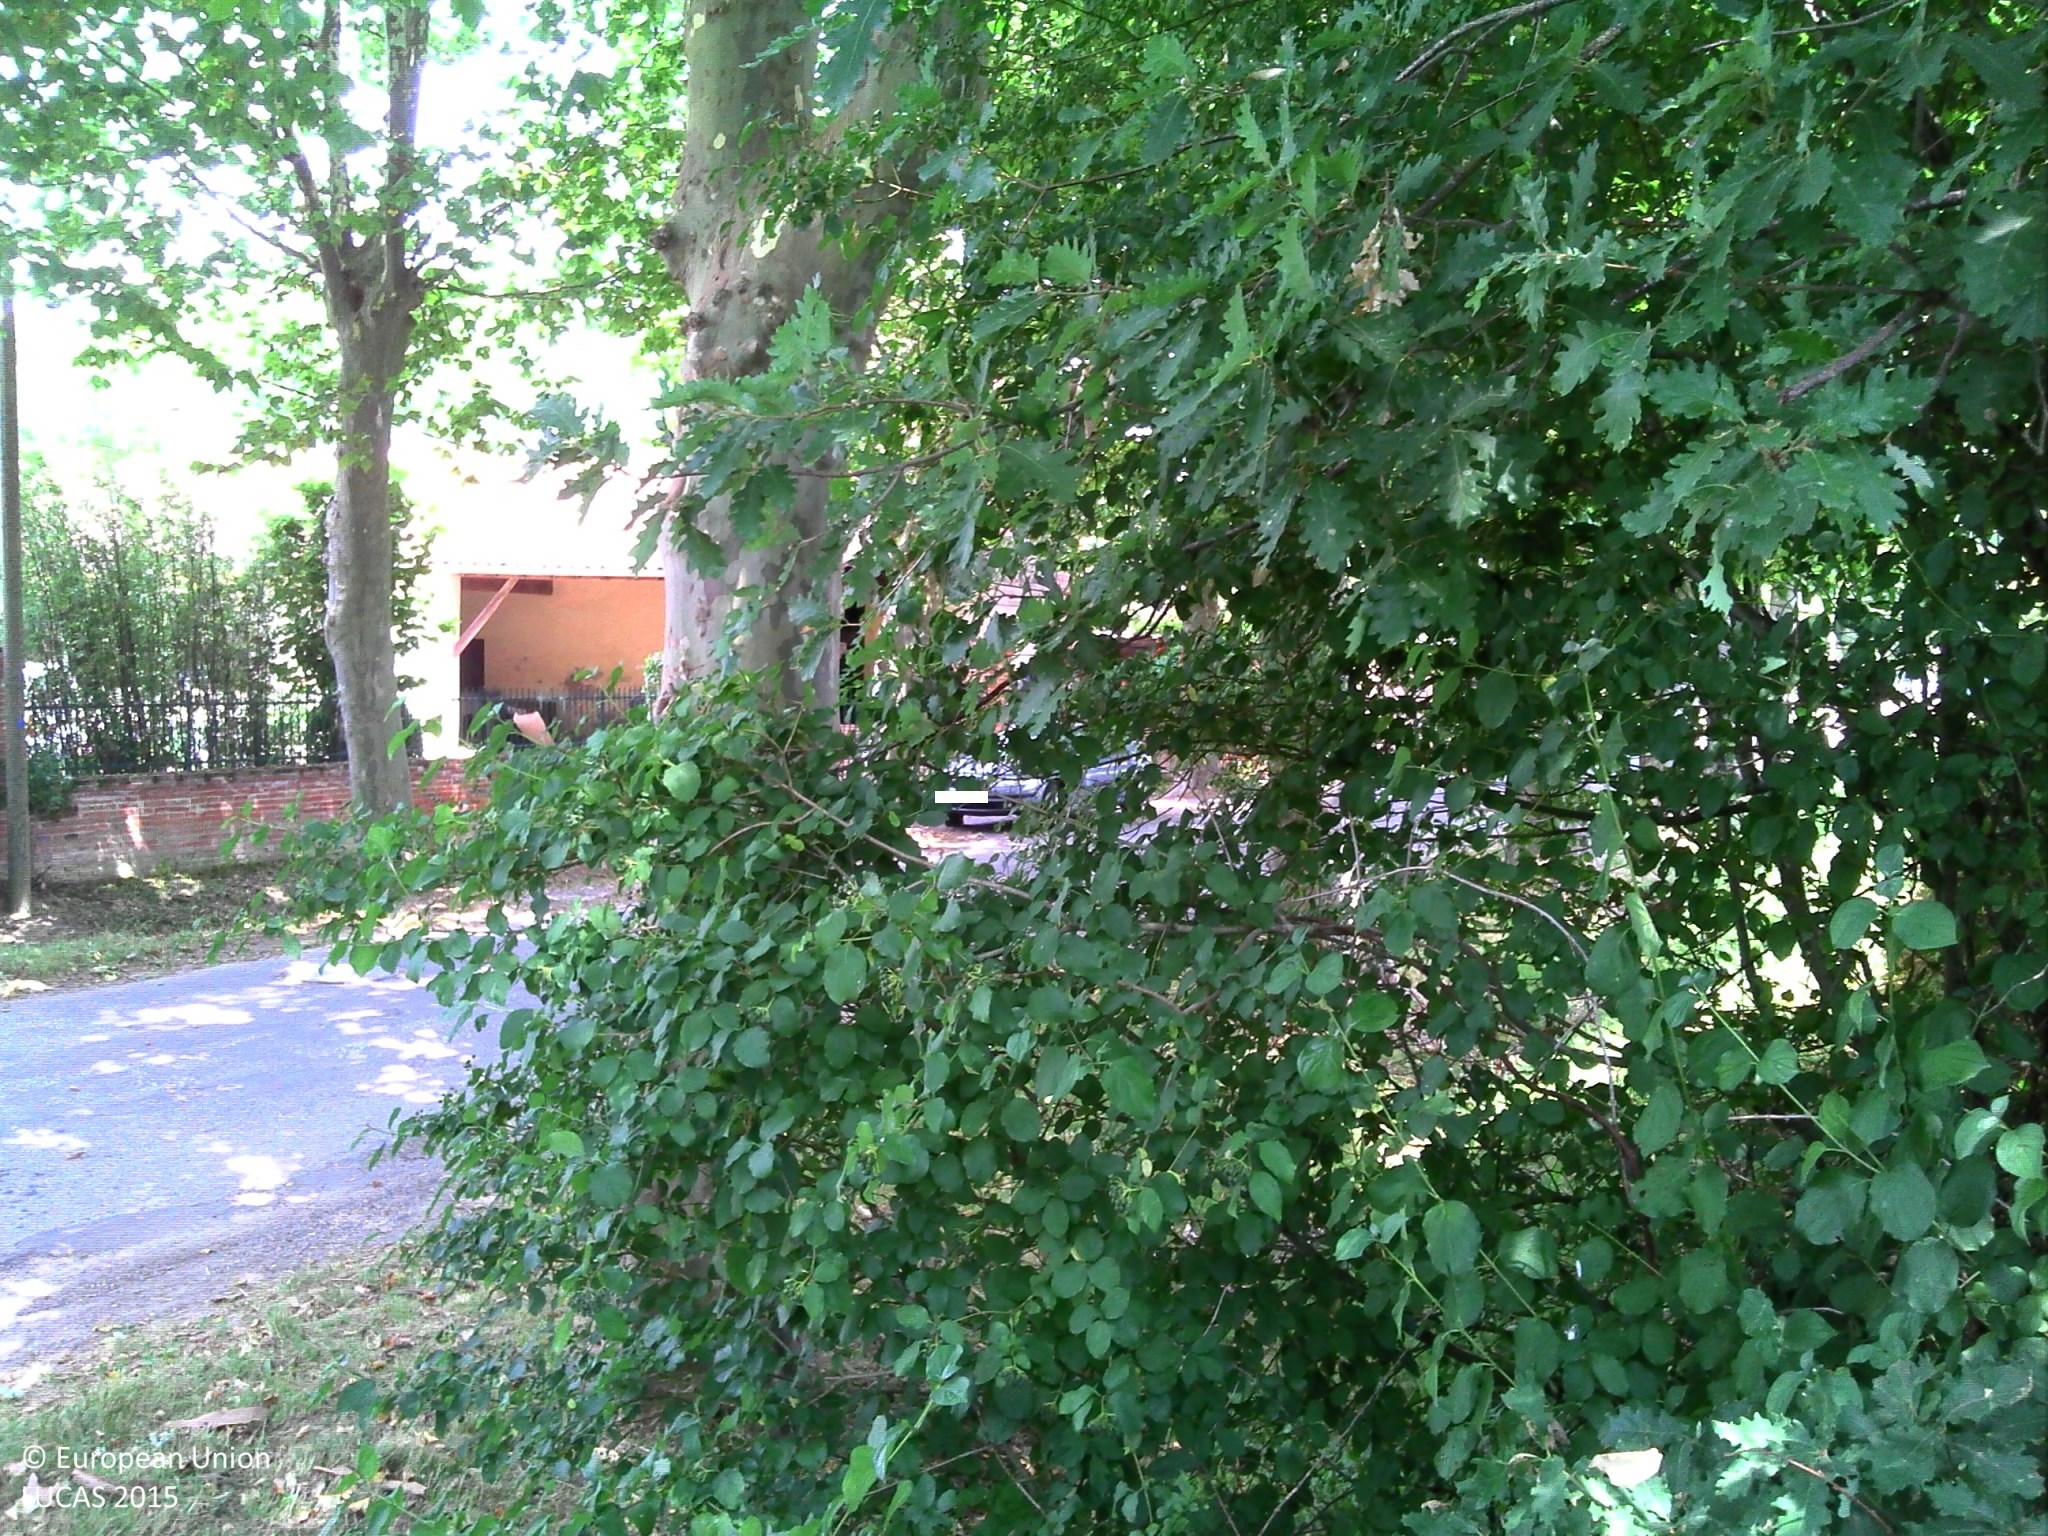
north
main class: Grassland
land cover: Grassland with sparse tree/shrub cover
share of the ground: > 75 %
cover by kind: herbaceous plants 95 %, broadleaved forest trees 5 %
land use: Residential
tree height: > 5 m
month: July
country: FR
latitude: 43.6816
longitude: 1.5800
